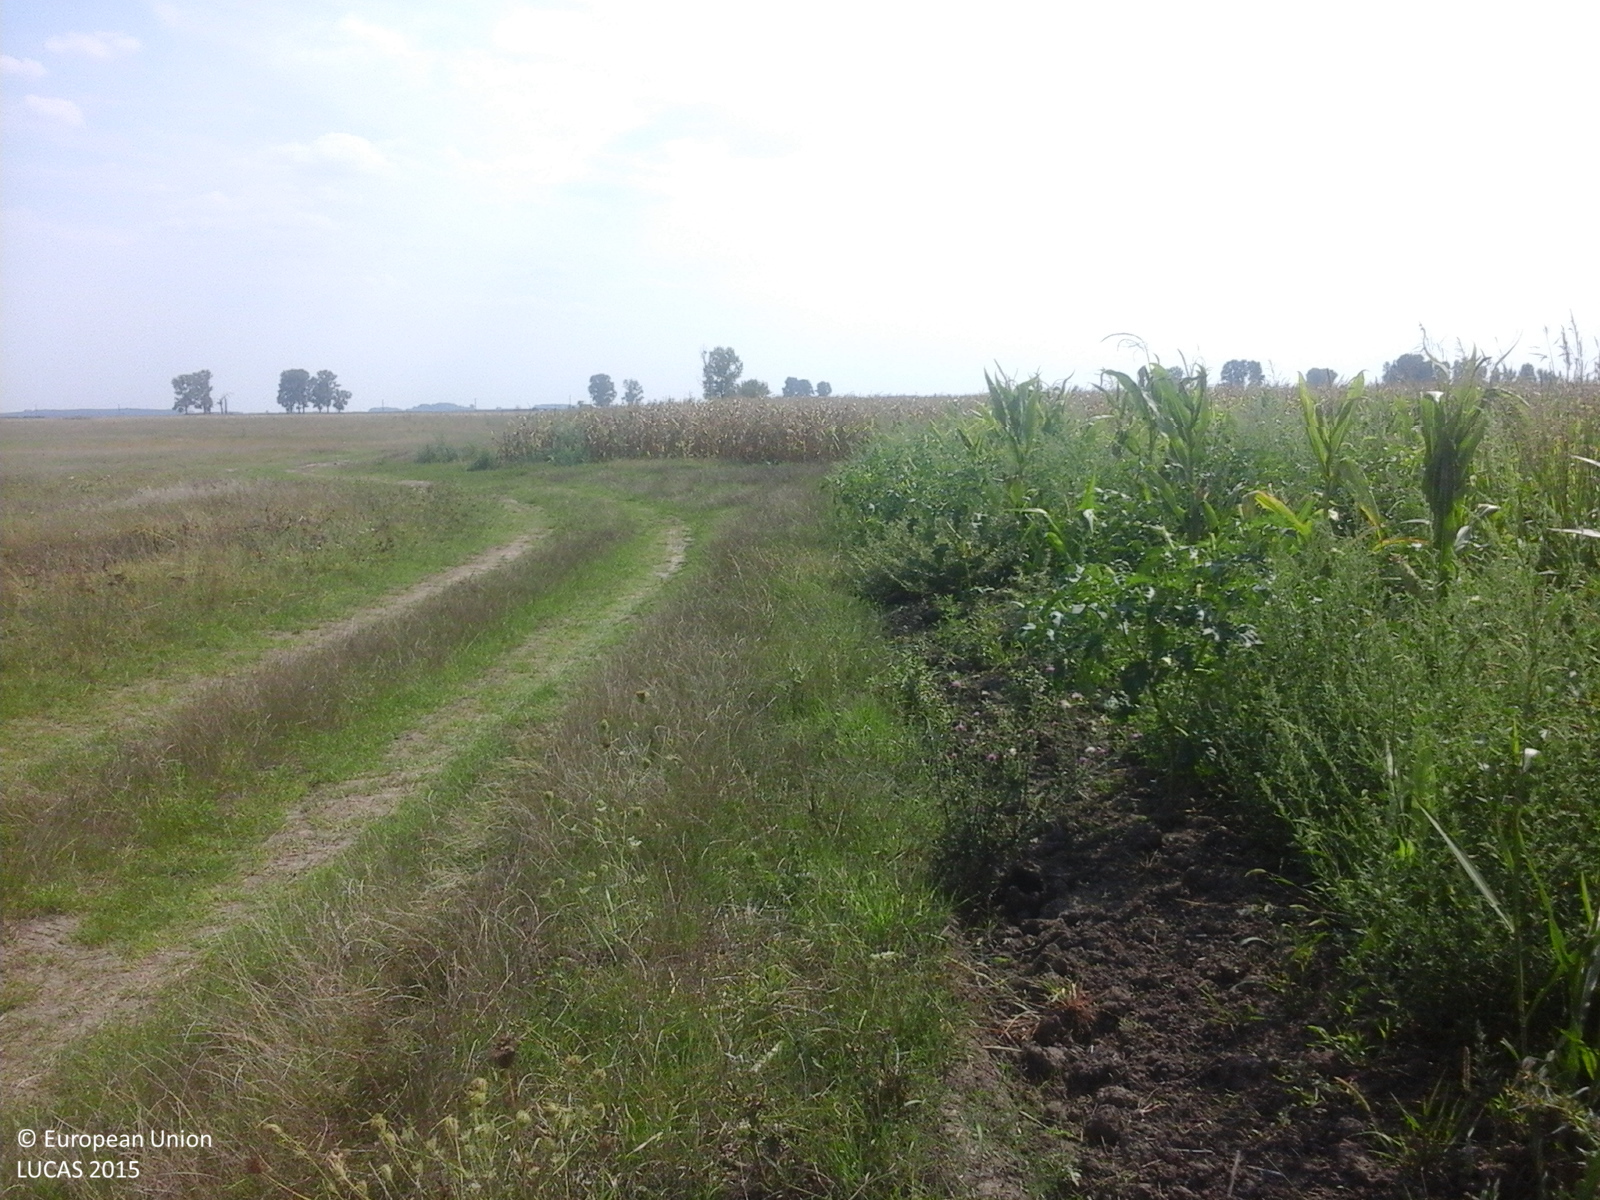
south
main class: Grassland
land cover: Spontaneously vegetated surfaces
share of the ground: > 75 %
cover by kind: herbaceous plants 100 %
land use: Fallow land
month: August
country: RO
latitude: 46.4158
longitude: 21.3676
